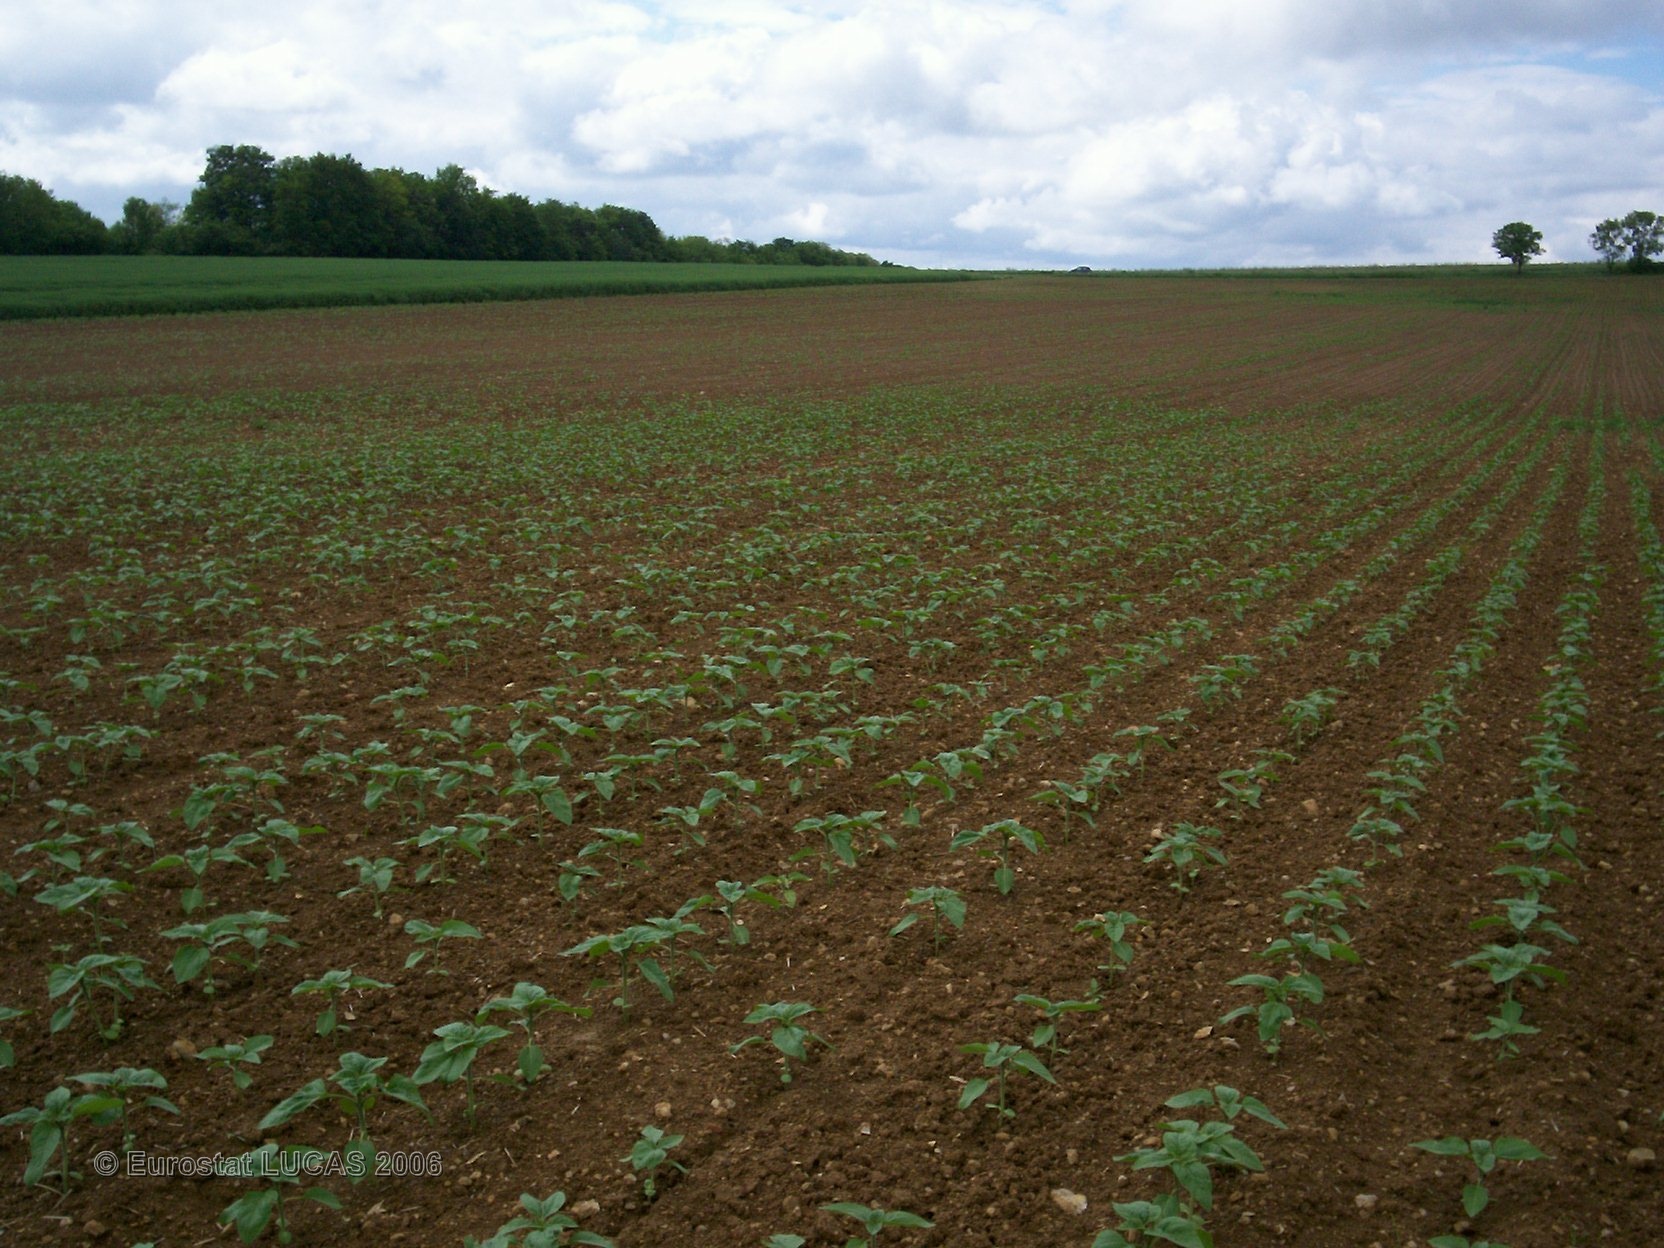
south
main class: Cropland
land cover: Sunflower
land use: Agriculture (excluding fallow land and kitchen gardens)
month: May
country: FR
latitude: 48.2687
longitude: 4.5413
